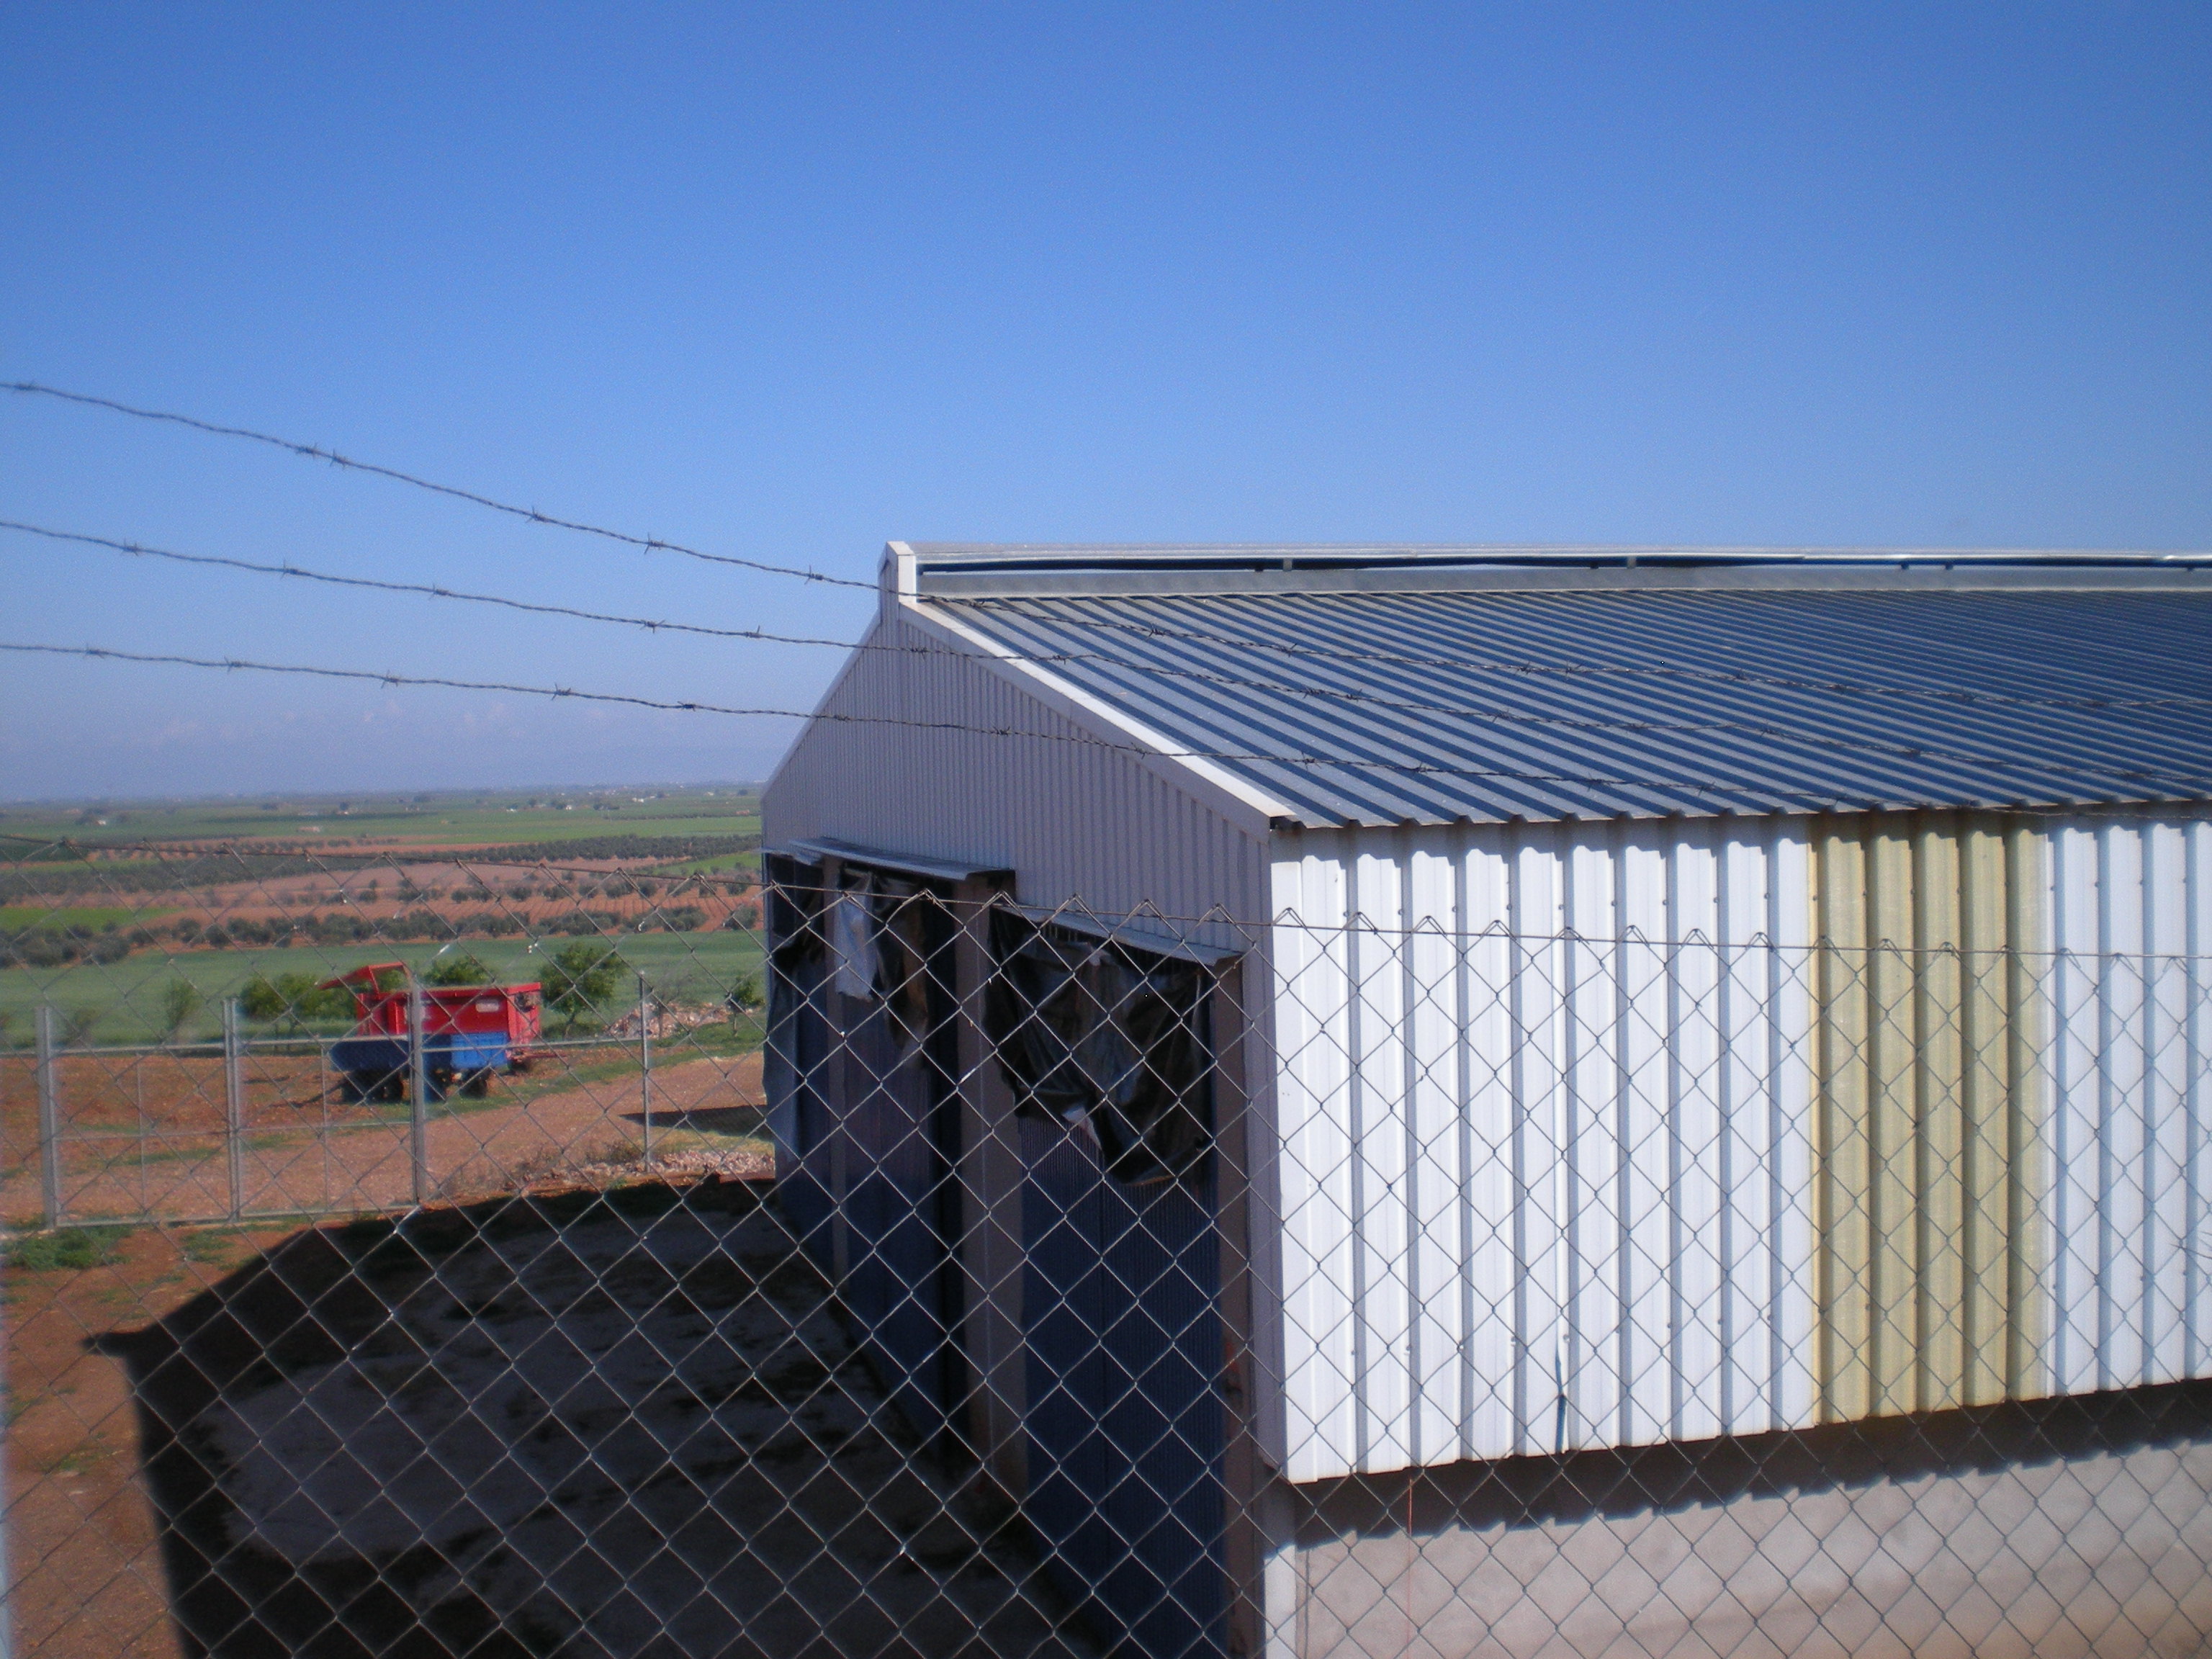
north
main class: Grassland
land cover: Grassland without tree/shrub cover
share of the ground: > 75 %
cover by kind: herbaceous plants 80 %, unconsolidated bare surface 20 %
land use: Agriculture (excluding fallow land and kitchen gardens)
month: April
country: ES
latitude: 38.9170
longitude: -3.5668
